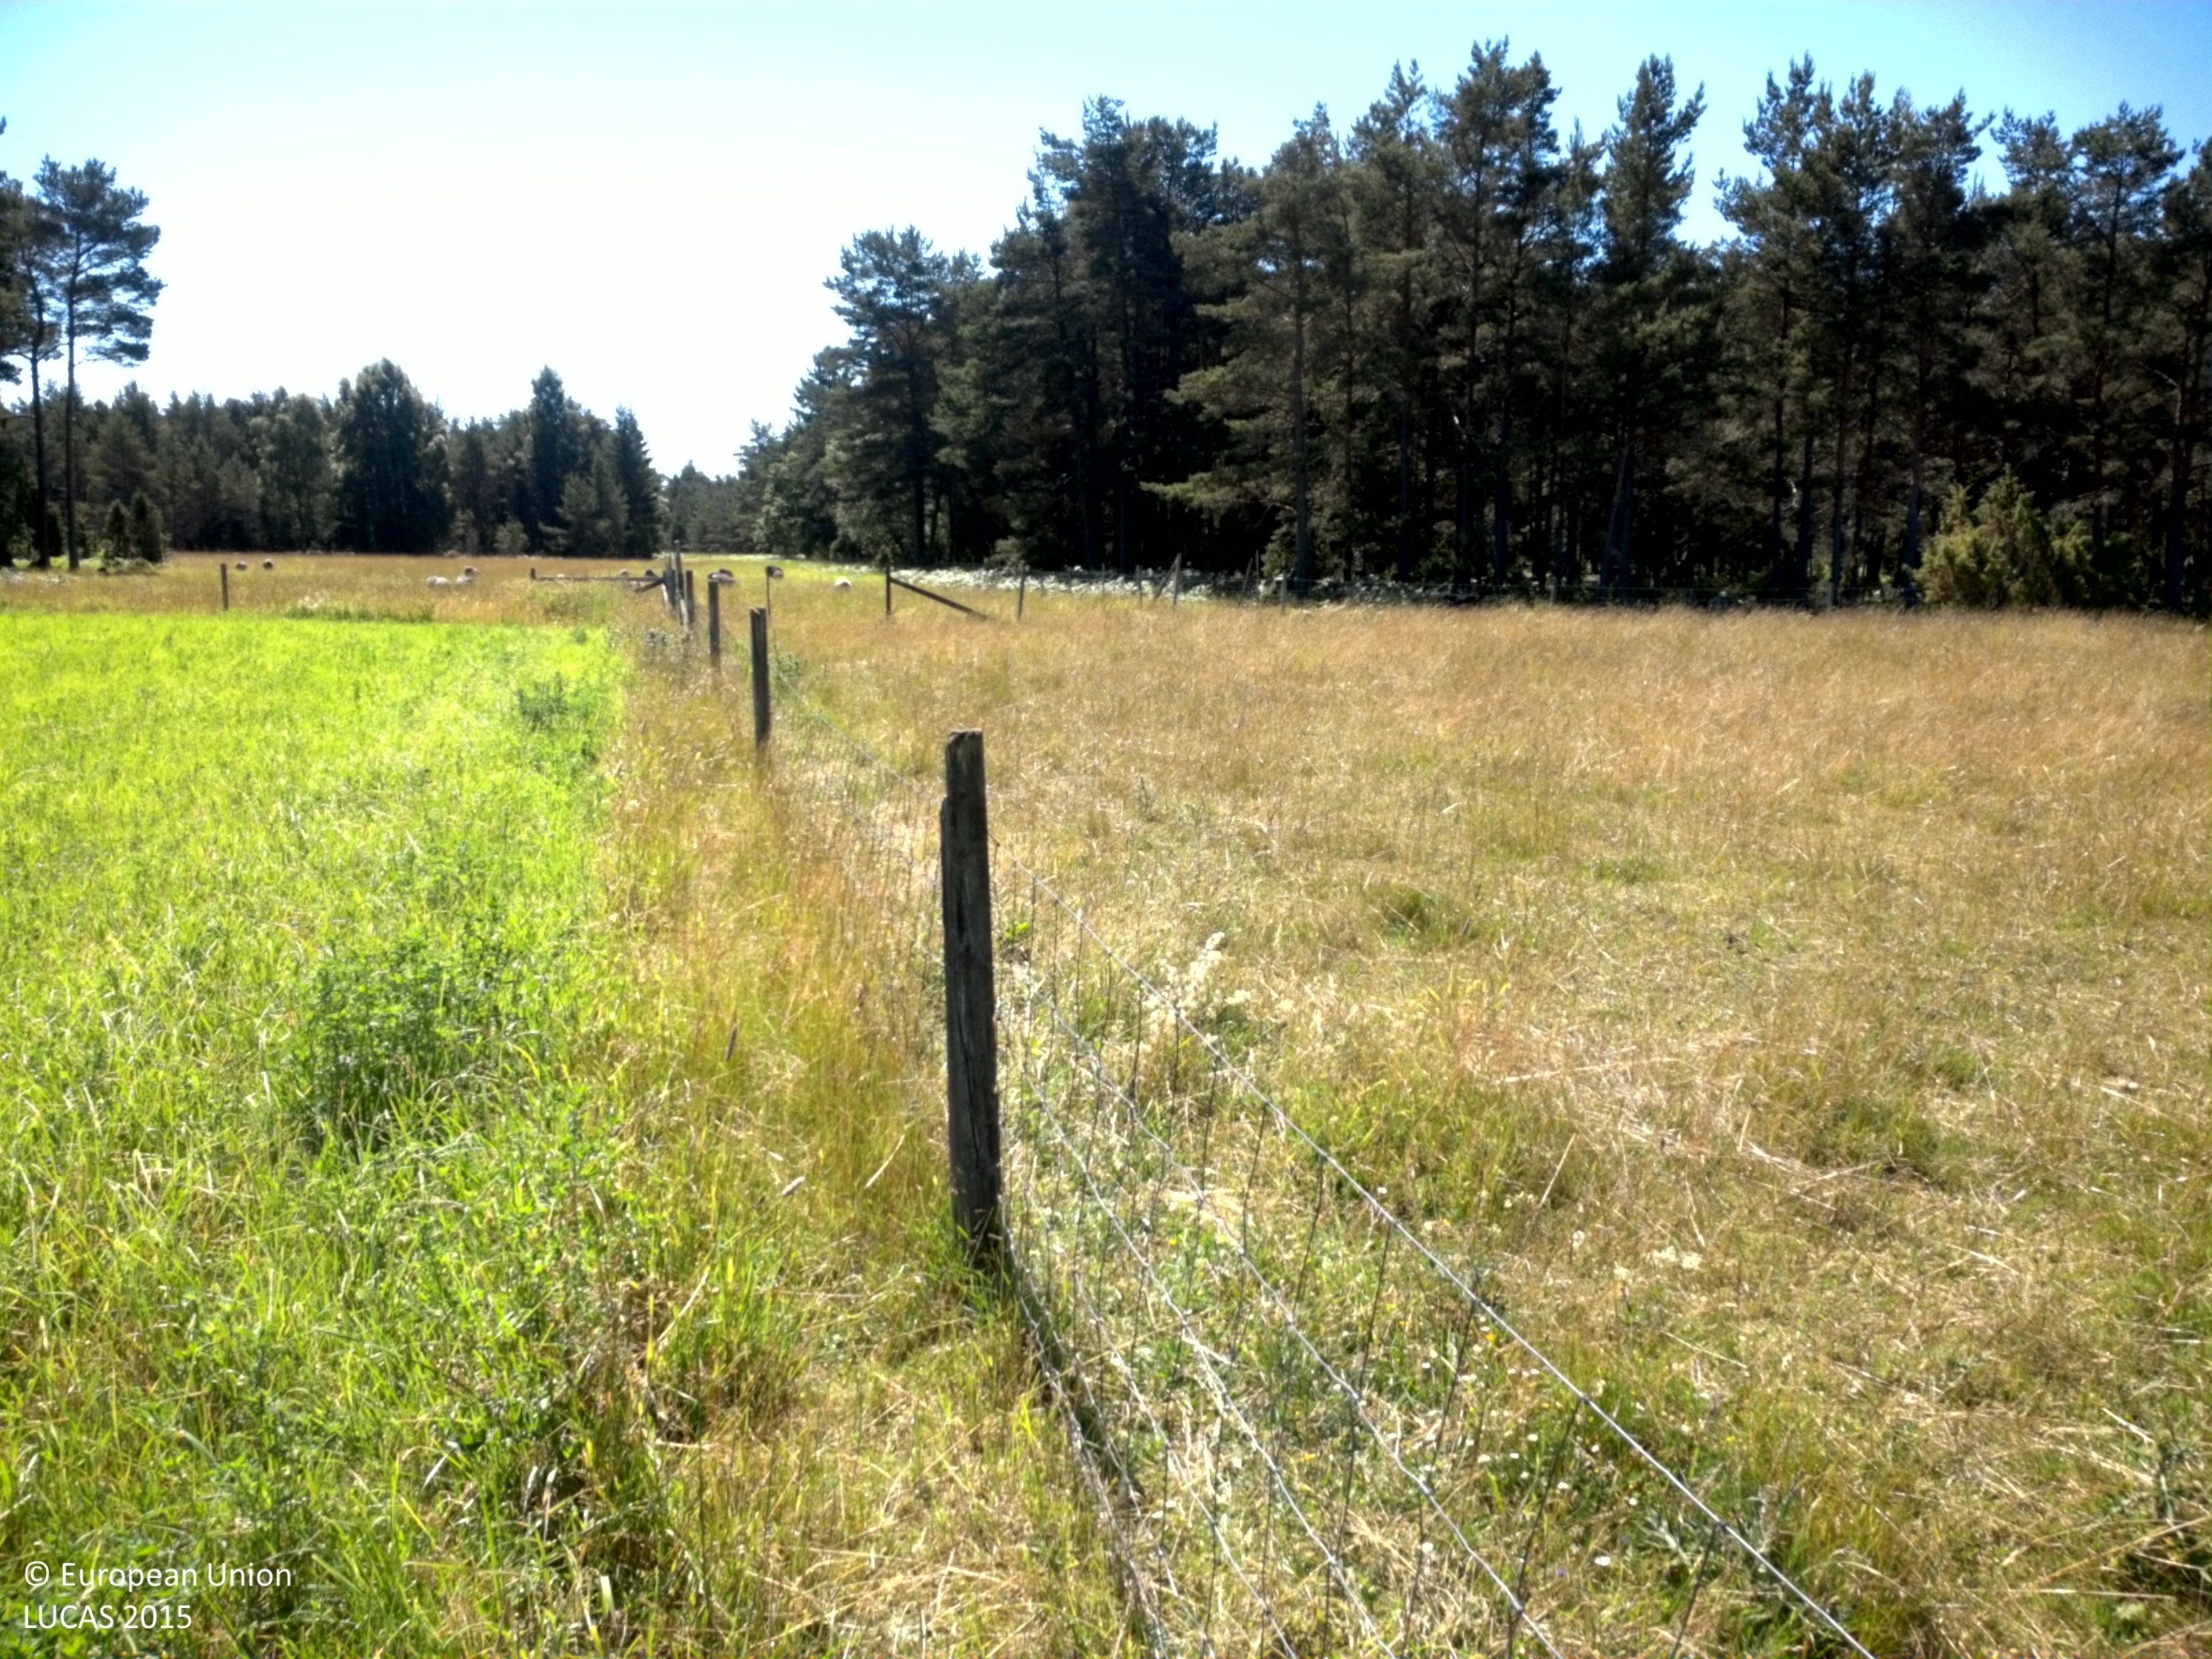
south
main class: Cropland
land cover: Lucerne
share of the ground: > 75 %
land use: Agriculture (excluding fallow land and kitchen gardens)
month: July
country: SE
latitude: 57.7541
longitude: 18.7306
